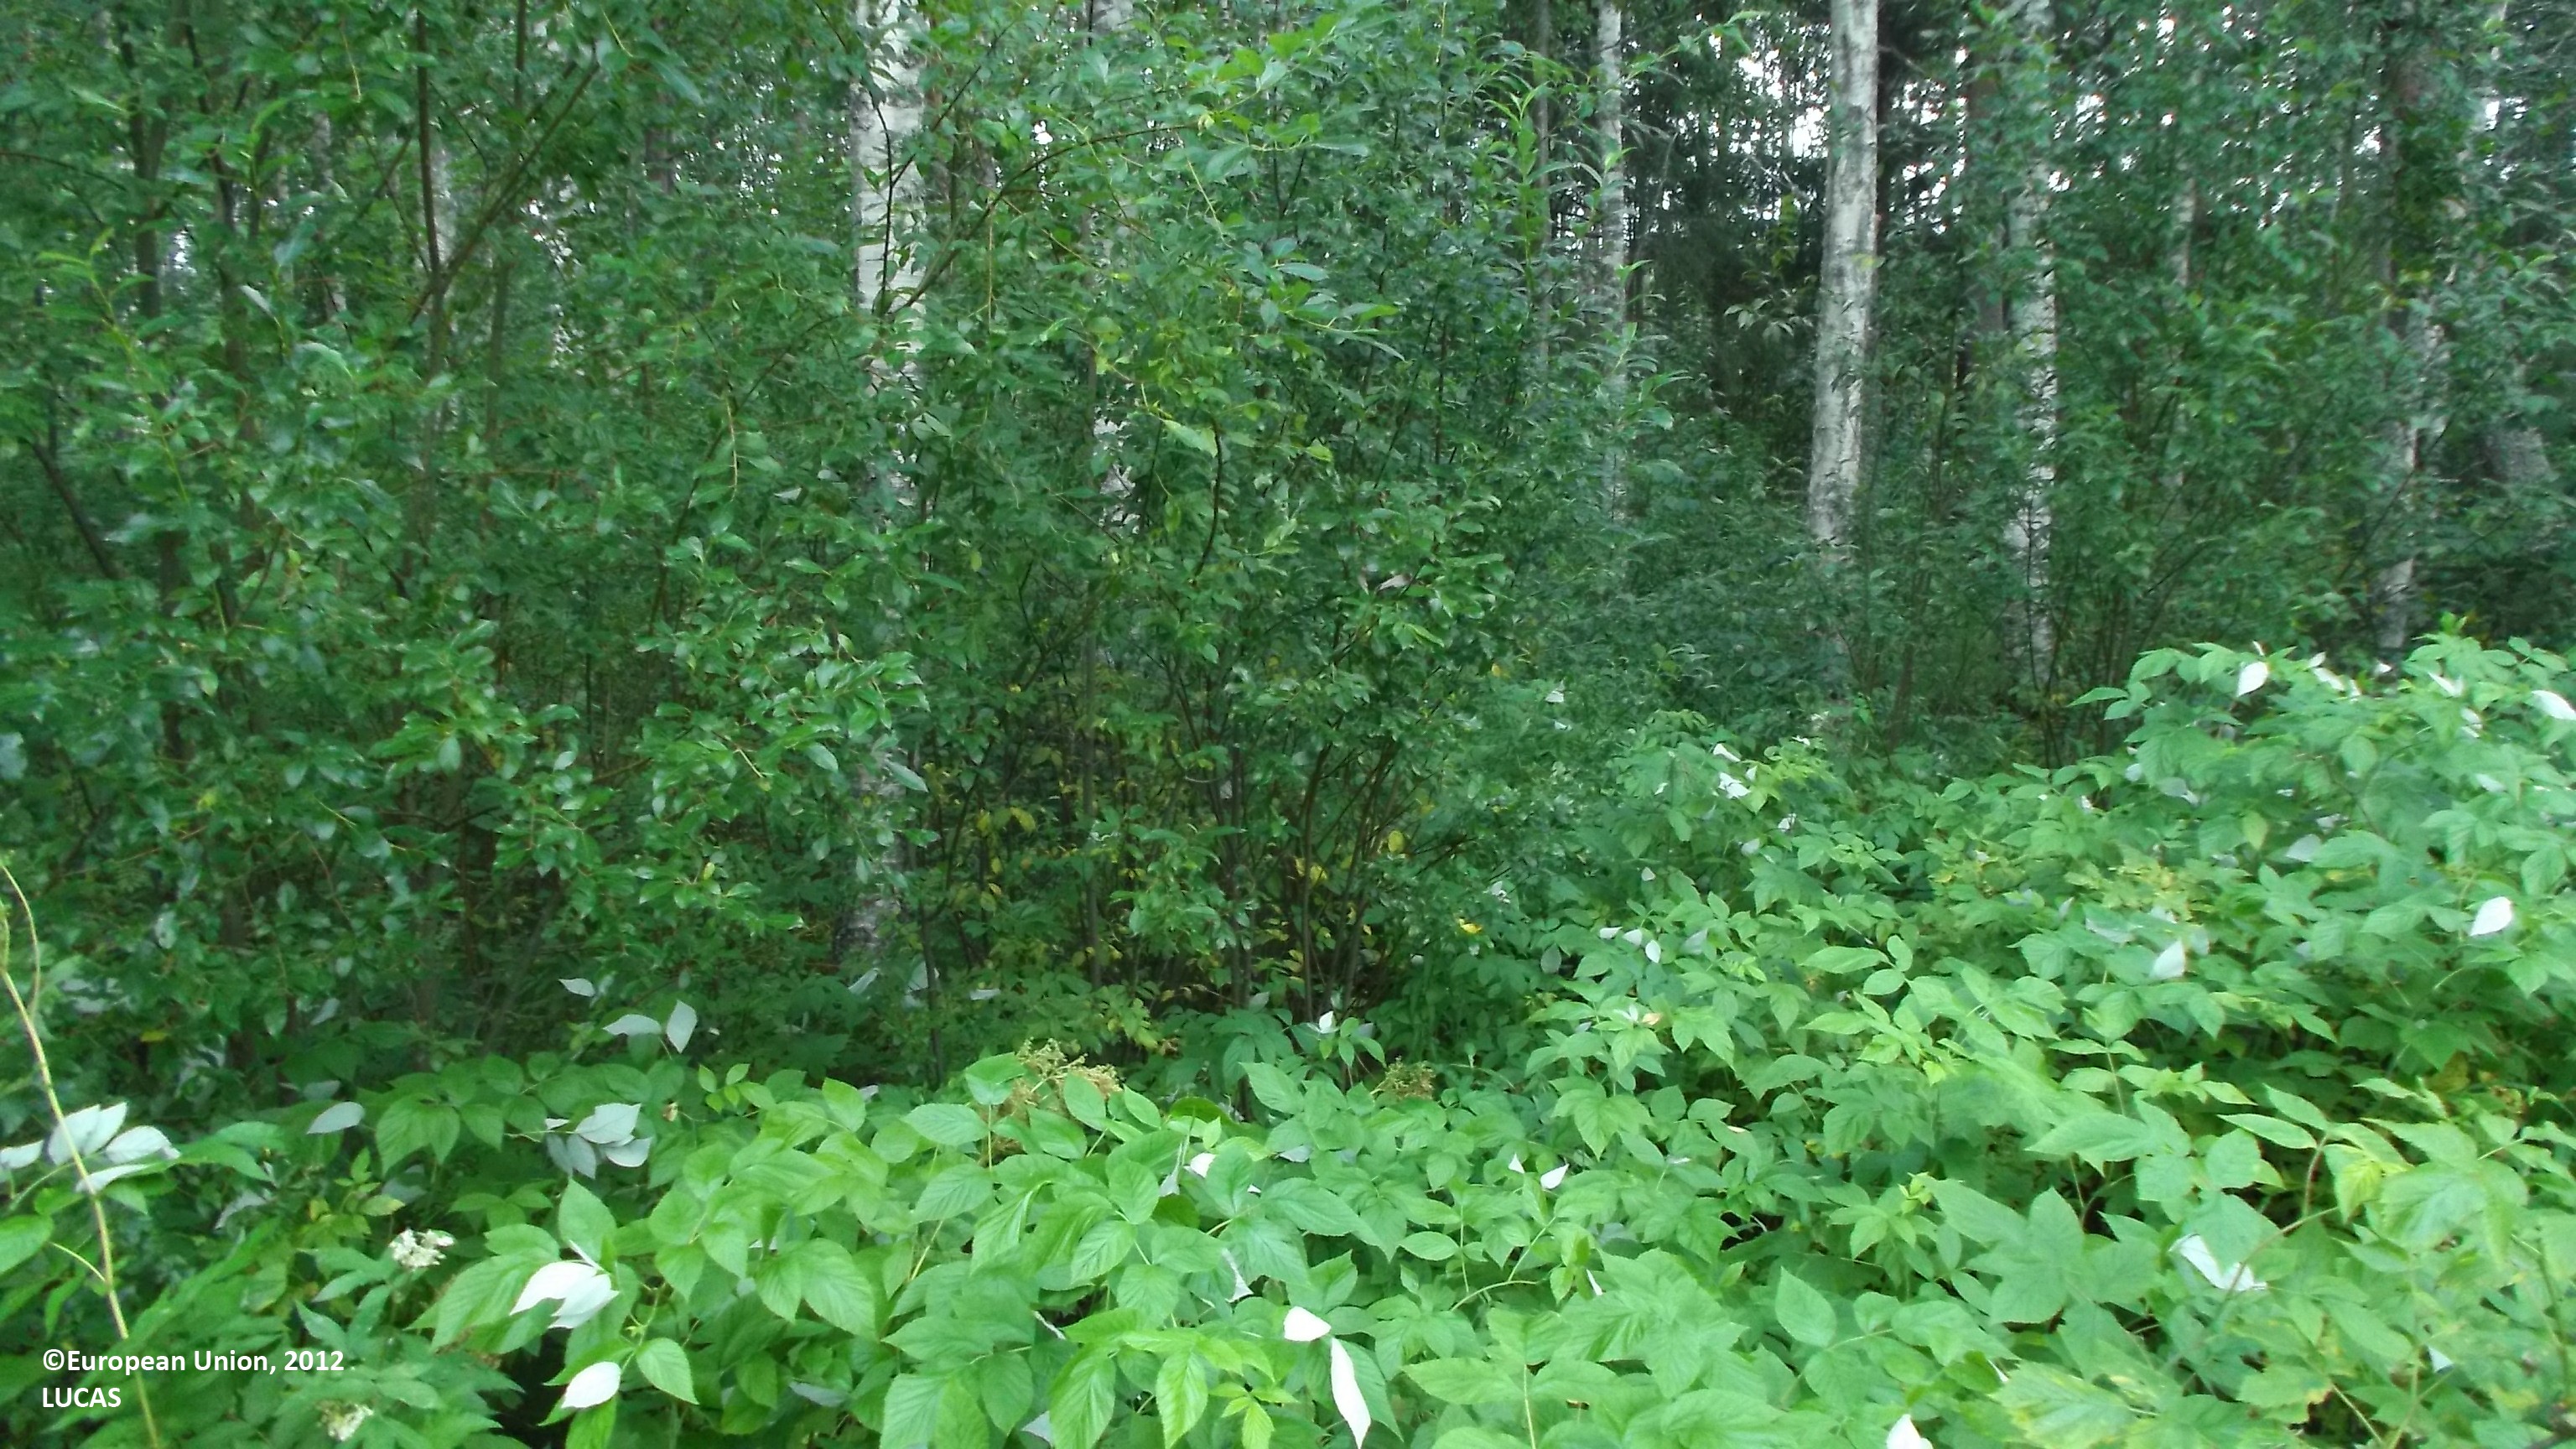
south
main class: Shrubland
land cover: Shrubland with sparse tree cover
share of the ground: 25 - 50 %
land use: Forestry
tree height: > 5 m
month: August
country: FI
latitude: 63.0745
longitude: 24.3932
